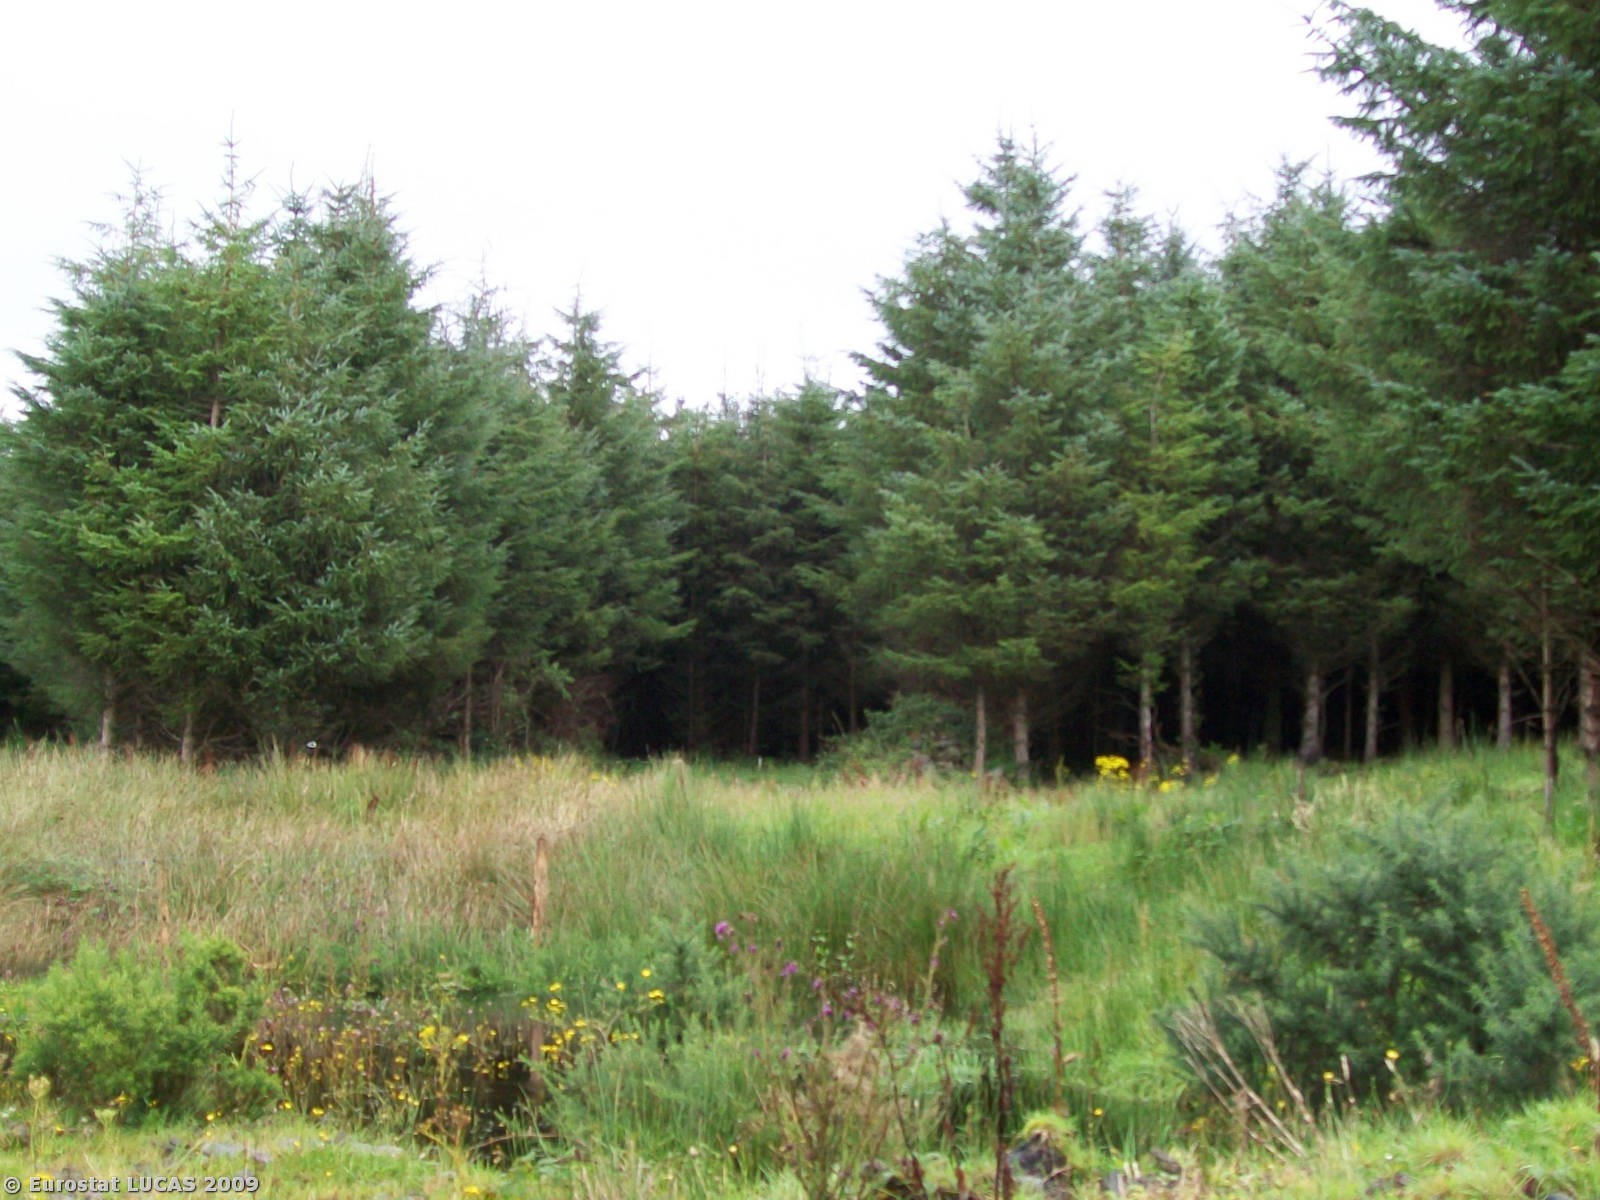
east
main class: Woodland
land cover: Coniferous woodland
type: plantations and self-sown exotic forest
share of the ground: > 75 %
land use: Forestry
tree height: > 5 m
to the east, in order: Coniferous woodland
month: August
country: IE
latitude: 52.9969
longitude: -9.2805
